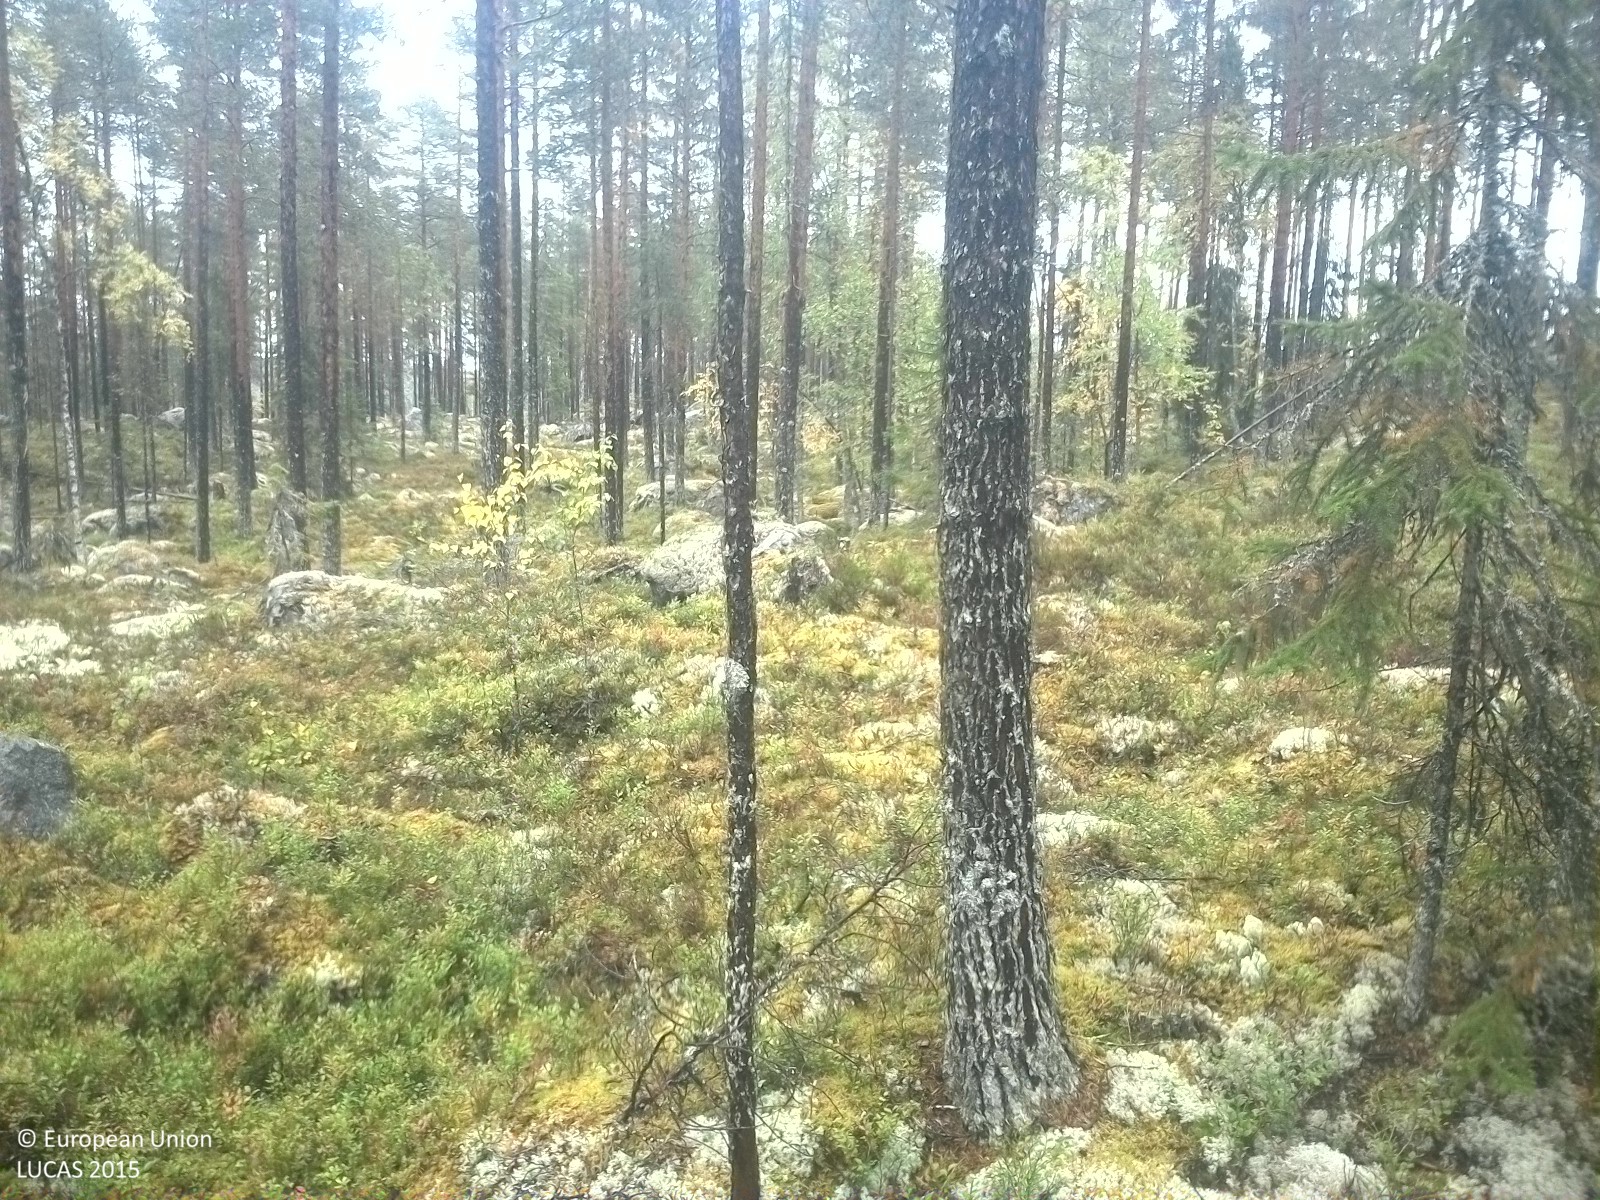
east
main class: Woodland
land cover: Pine dominated coniferous woodland
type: boreal forest
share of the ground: 25 - 50 %
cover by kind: coniferous forest trees 40 %, lichens and mosses 40 %, shrubs 20 %
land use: Forestry
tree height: > 5 m
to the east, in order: Pine dominated coniferous woodland; Shrubland with sparse tree cover; Other mixed woodland
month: September
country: SE
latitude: 62.2155
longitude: 15.6920
